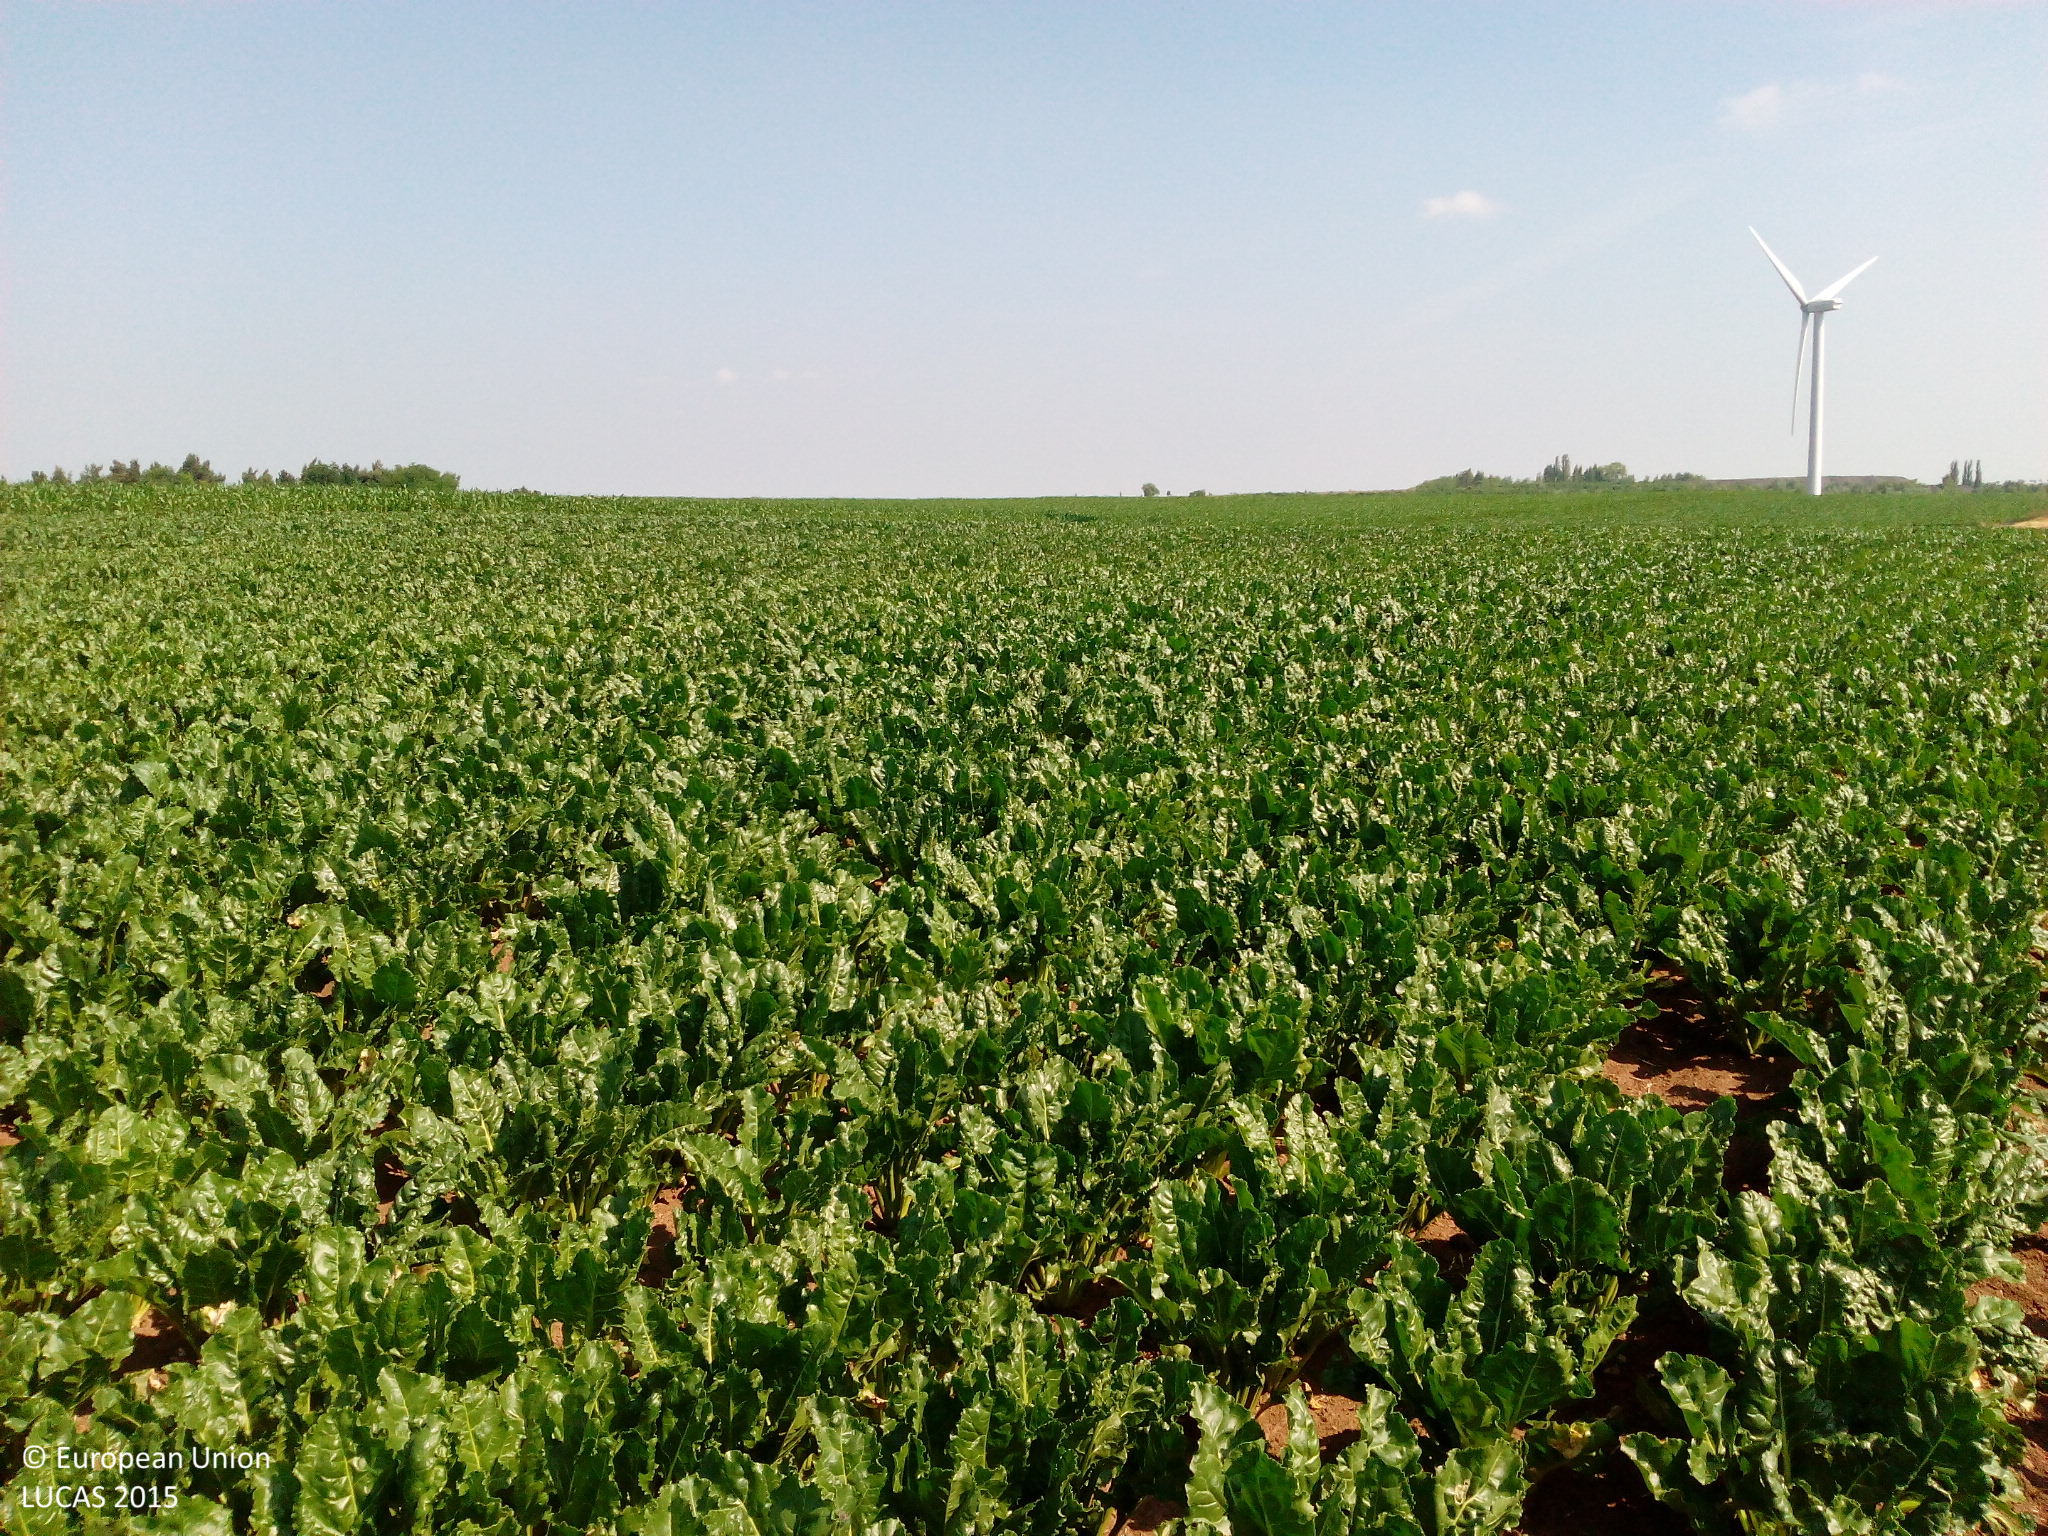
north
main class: Cropland
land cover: Maize
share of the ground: > 75 %
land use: Agriculture (excluding fallow land and kitchen gardens)
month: June
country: DE
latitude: 51.6127
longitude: 11.5160
